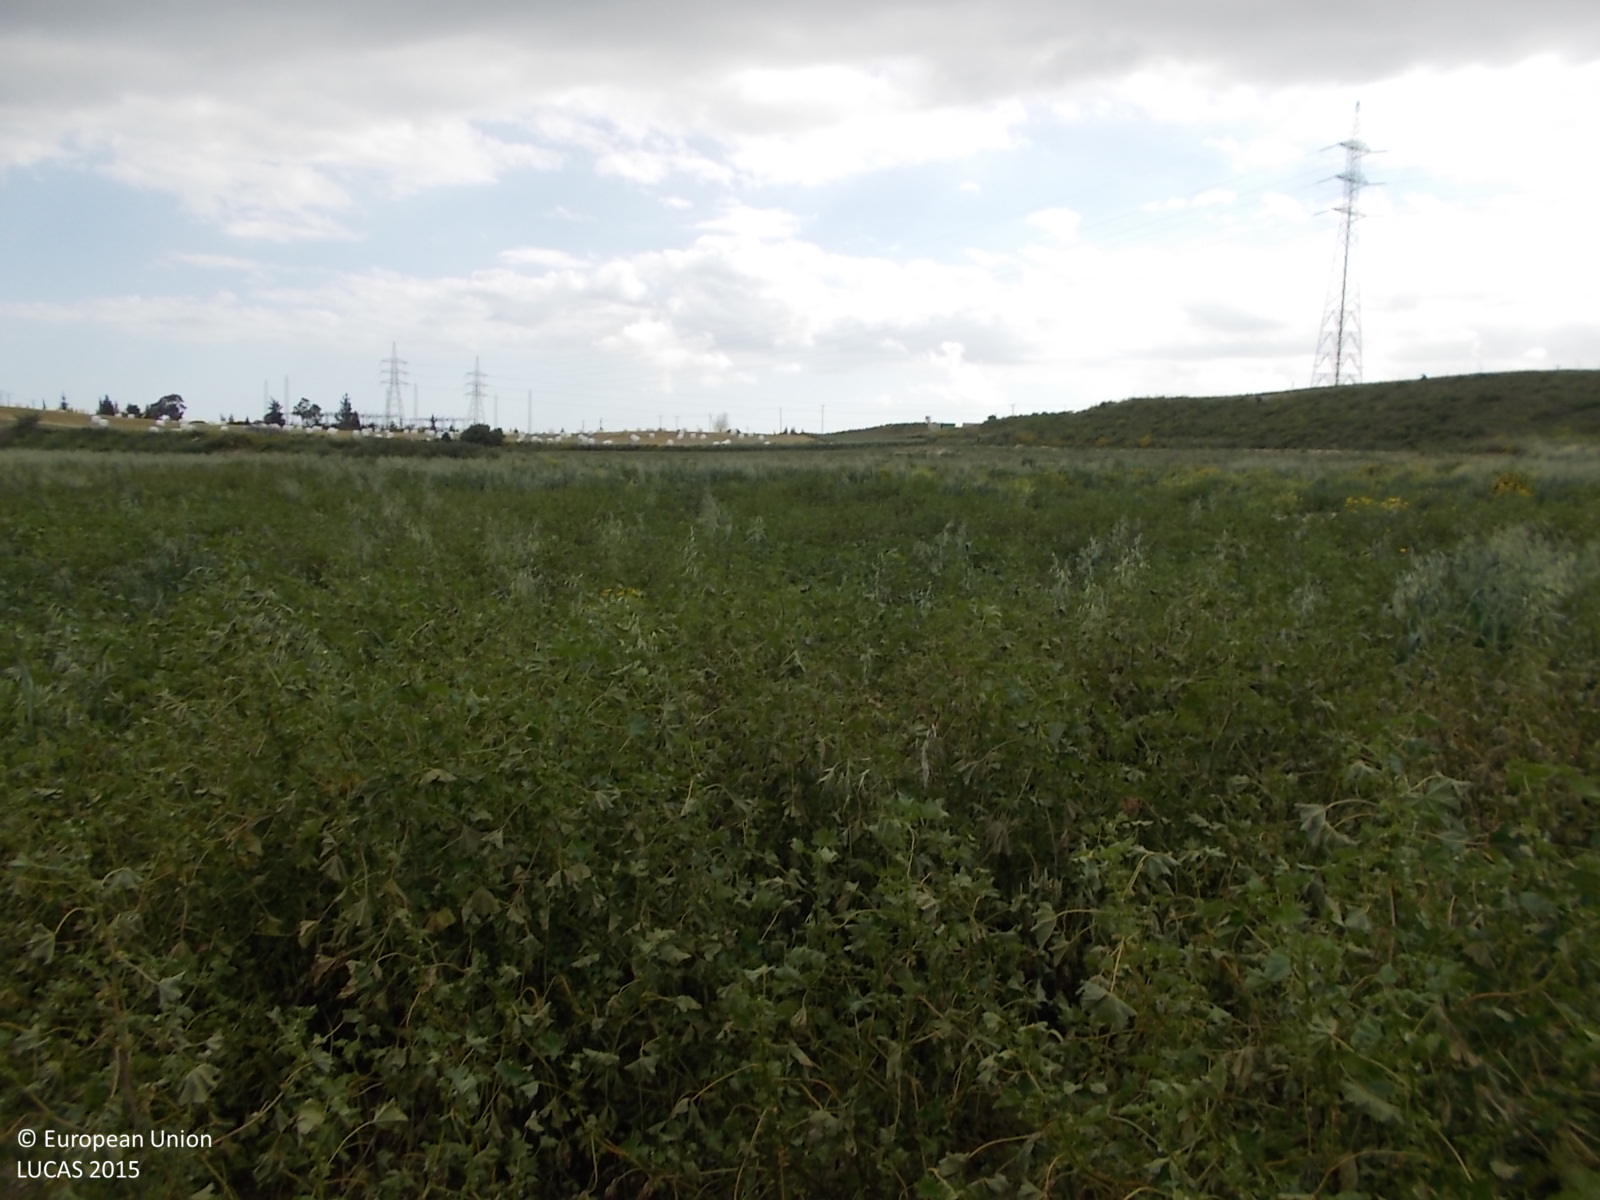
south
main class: Cropland
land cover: Other fresh vegetables
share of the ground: > 75 %
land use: Agriculture (excluding fallow land and kitchen gardens)
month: April
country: CY
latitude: 34.9115
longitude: 33.5609
